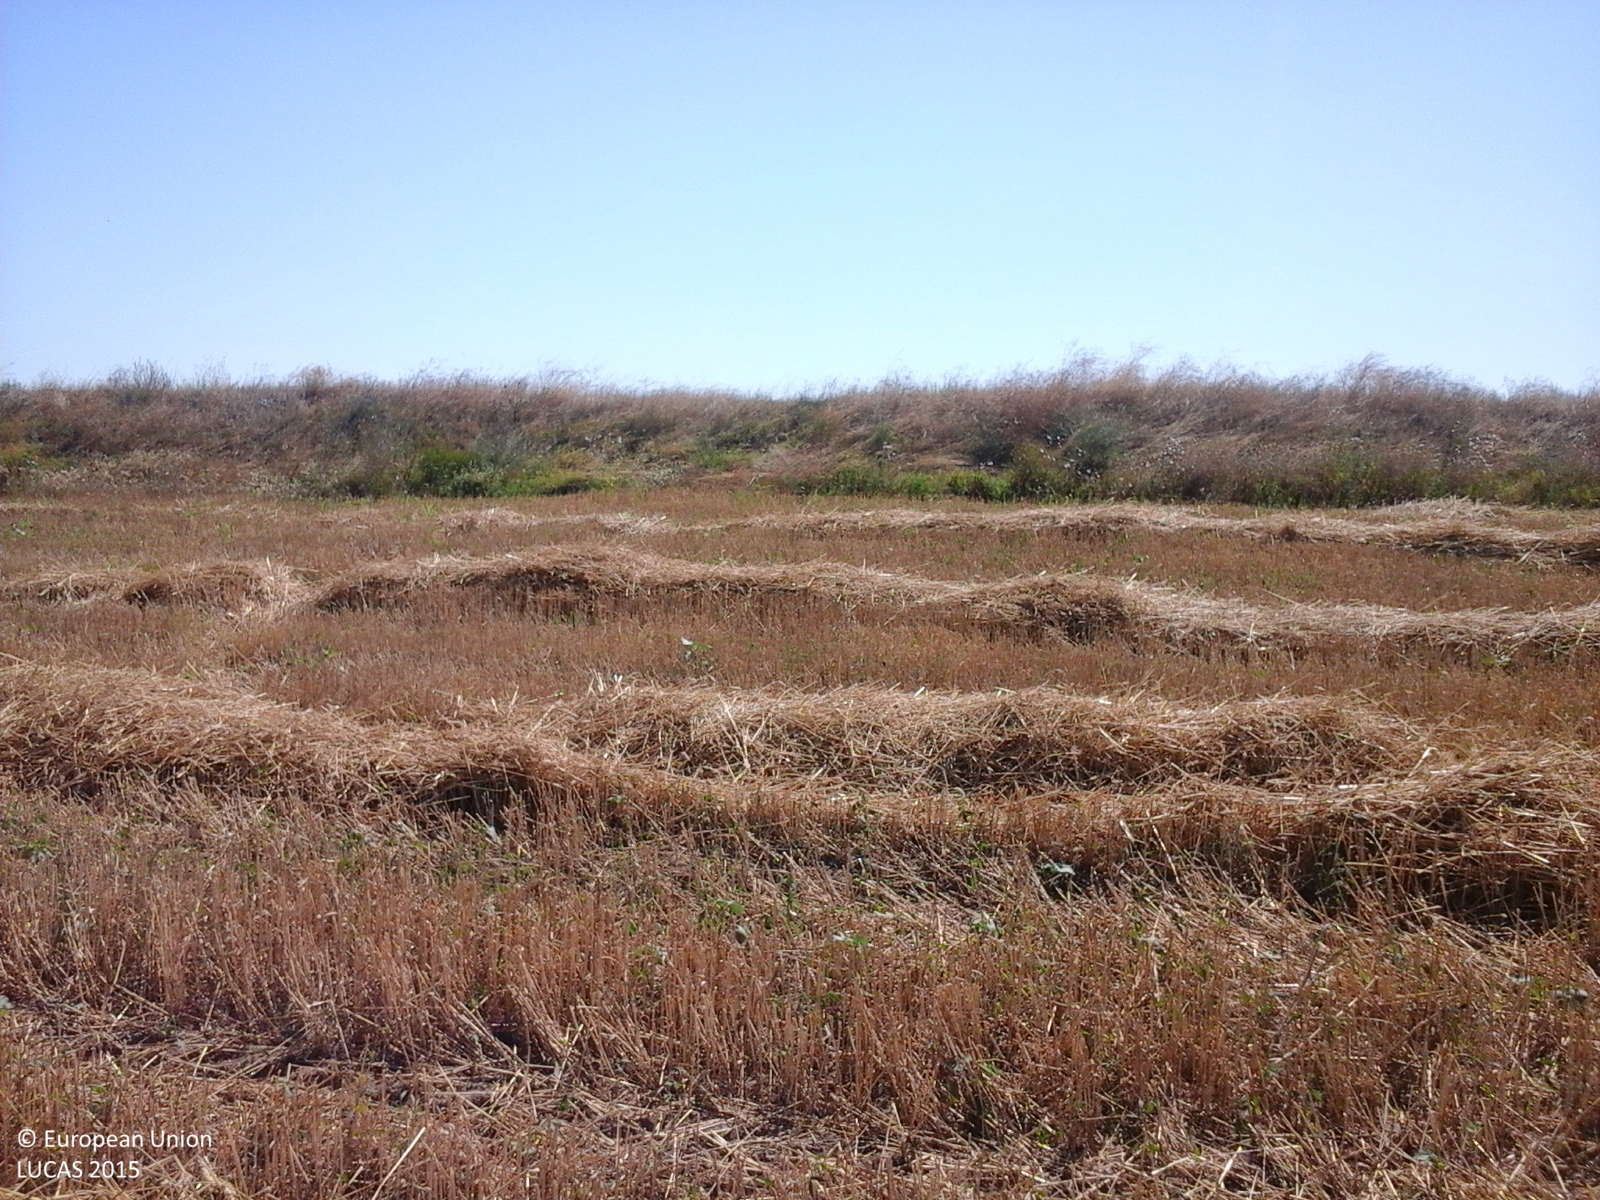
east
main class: Cropland
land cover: Common wheat
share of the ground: 50 - 75 %
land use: Agriculture (excluding fallow land and kitchen gardens)
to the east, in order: Common wheat; Grass margins; Tracks; Grassland without tree/shrub cover; Ditches and canals; Common wheat; Grassland without tree/shrub cover; Ditches and canals; Grassland without tree/shrub cover; Tracks; Grass margins; Rape and turnip rape
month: August
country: RO
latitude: 44.6812
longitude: 28.0903
